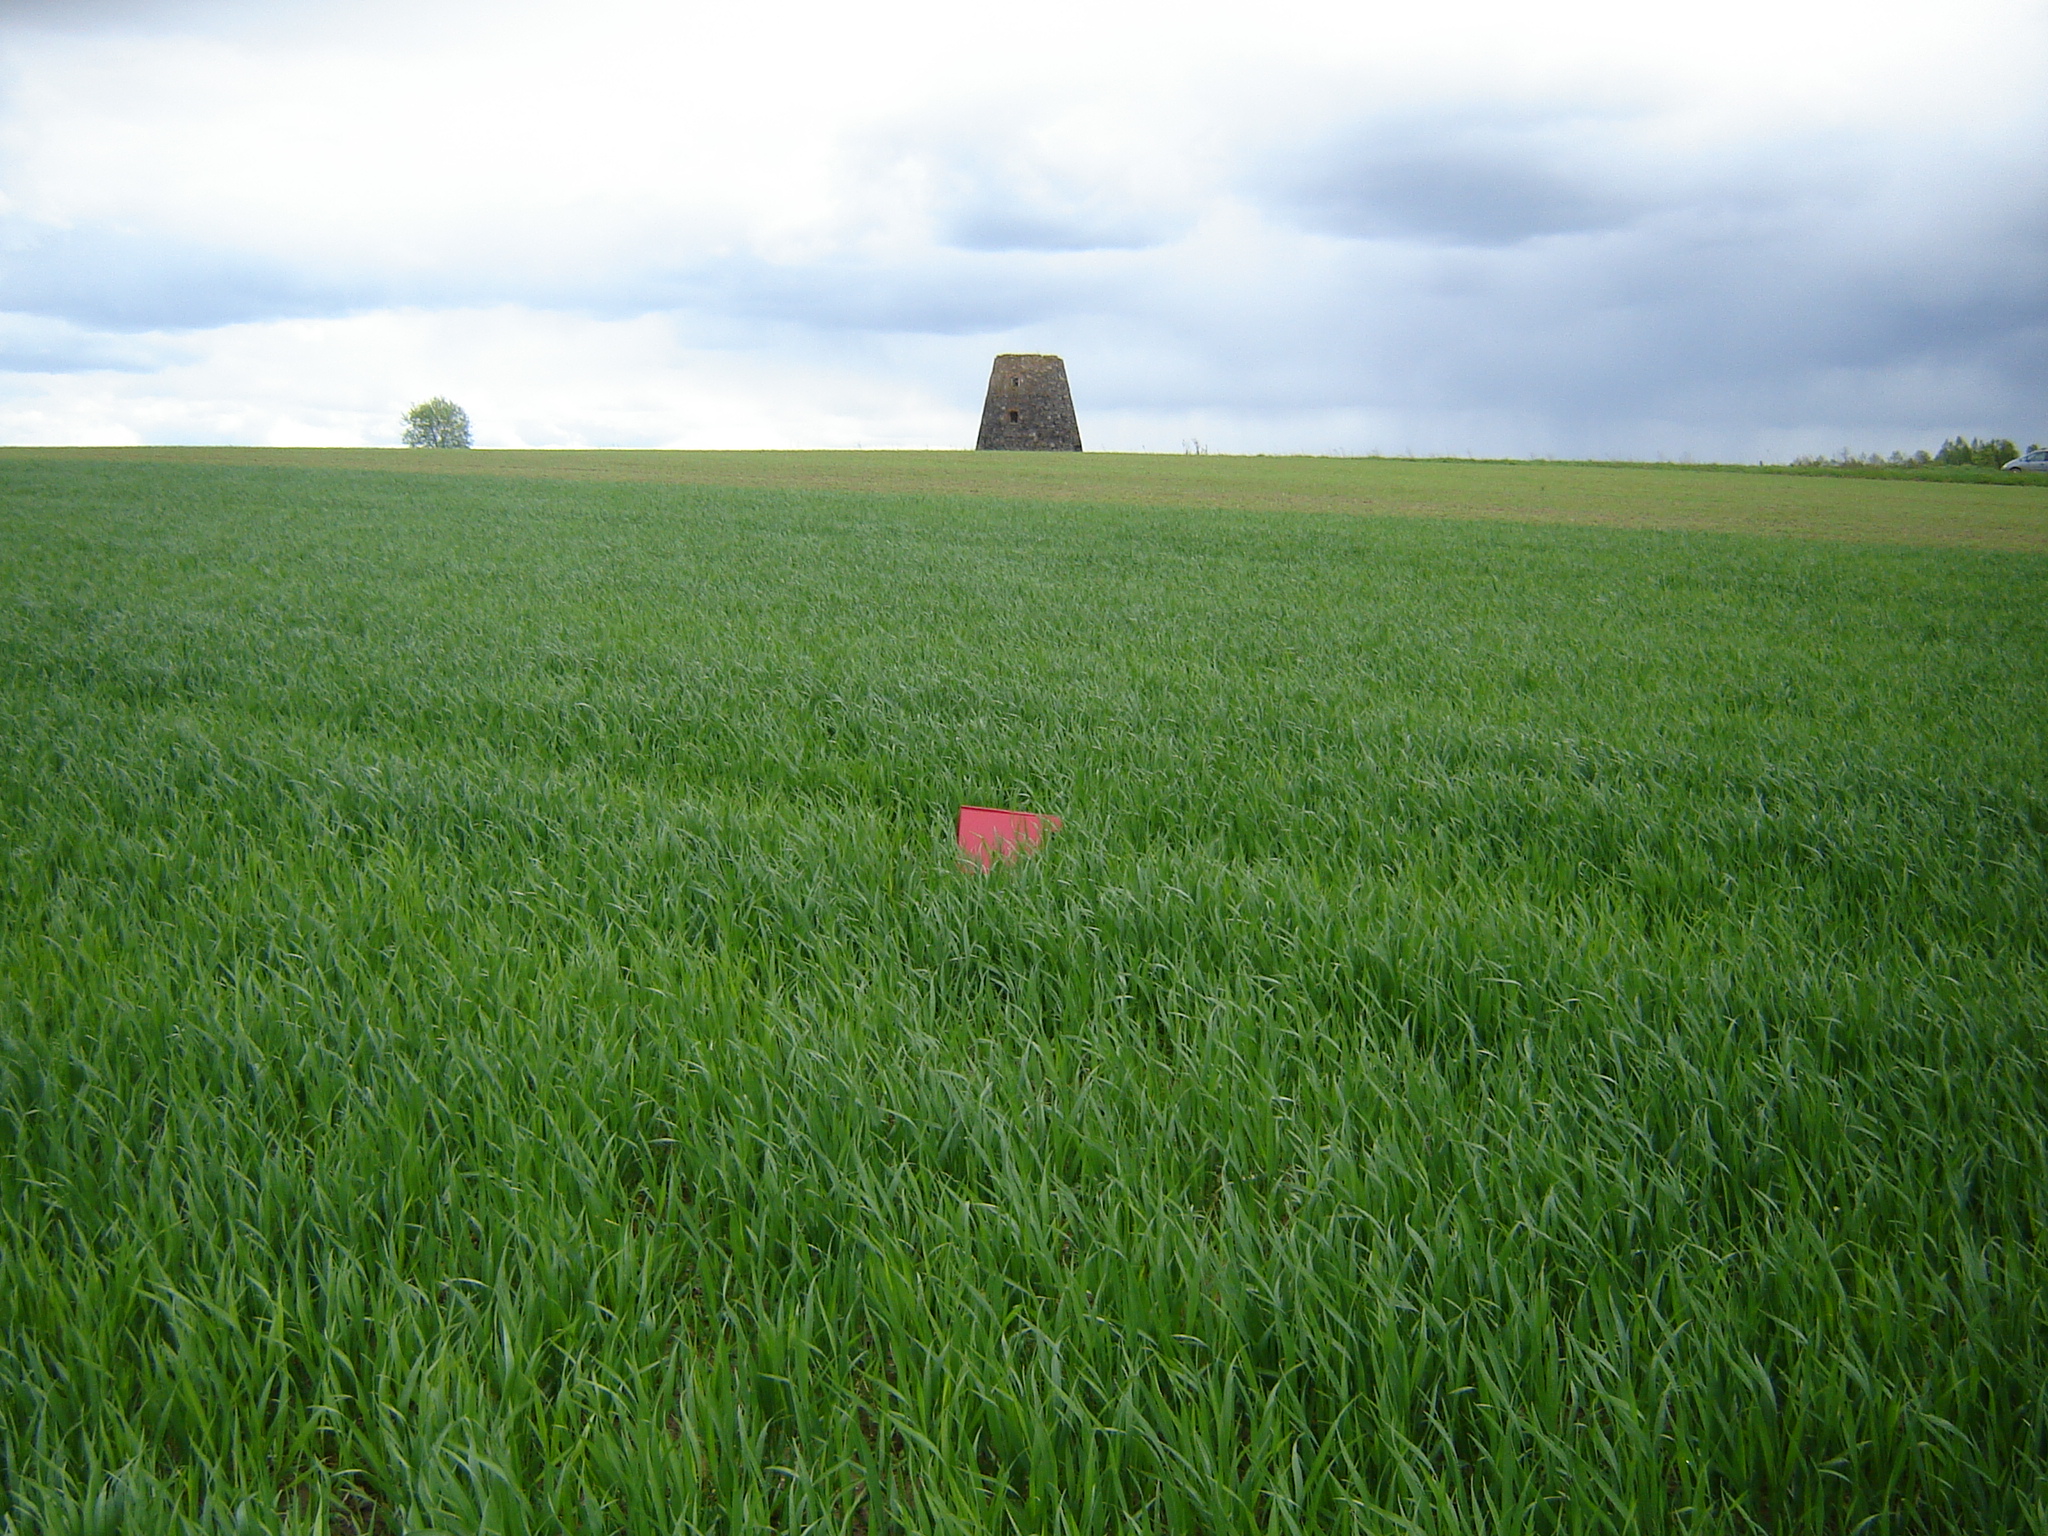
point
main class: Cropland
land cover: Barley
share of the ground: > 75 %
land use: Agriculture (excluding fallow land and kitchen gardens)
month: May
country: LT
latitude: 56.1320
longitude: 25.3880
